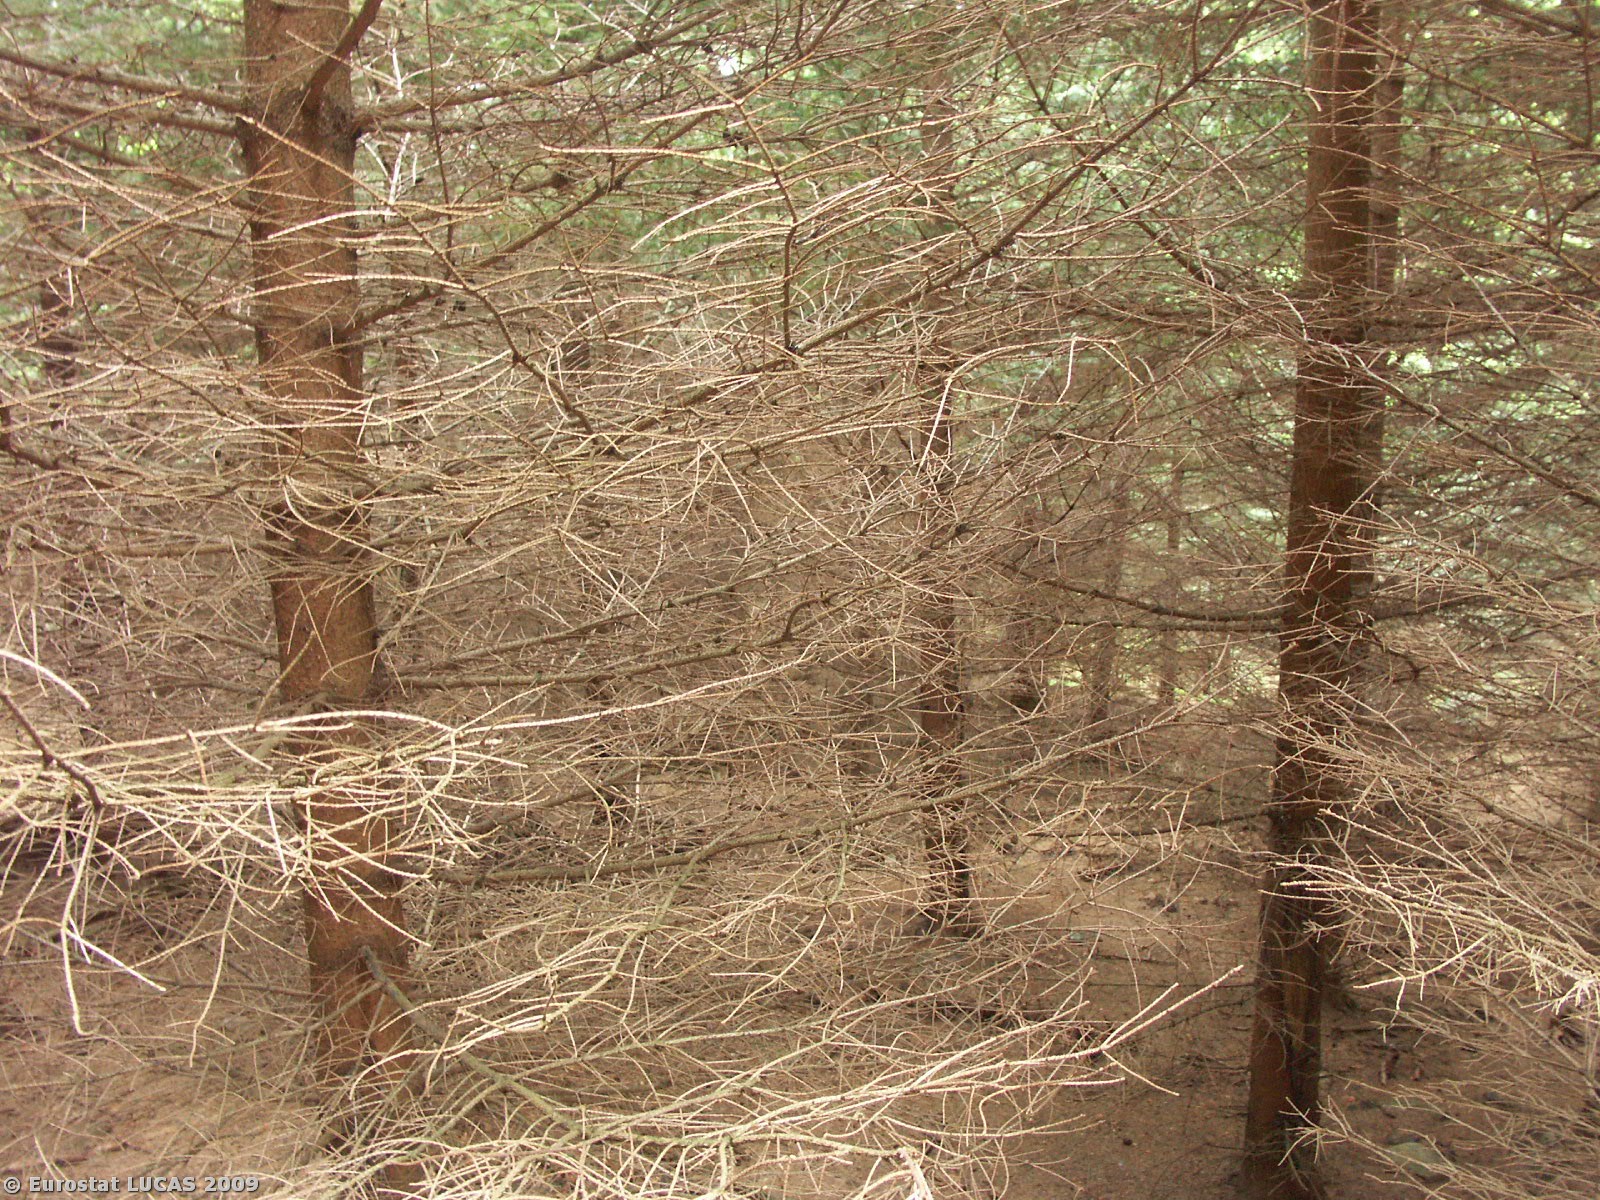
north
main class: Woodland
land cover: Coniferous woodland
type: hemiboreal forest and nemoral coniferous forest and mixed broadleaved-coniferous forest
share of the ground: > 75 %
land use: Forestry
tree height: > 5 m
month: May
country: CZ
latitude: 48.8796
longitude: 14.2687
